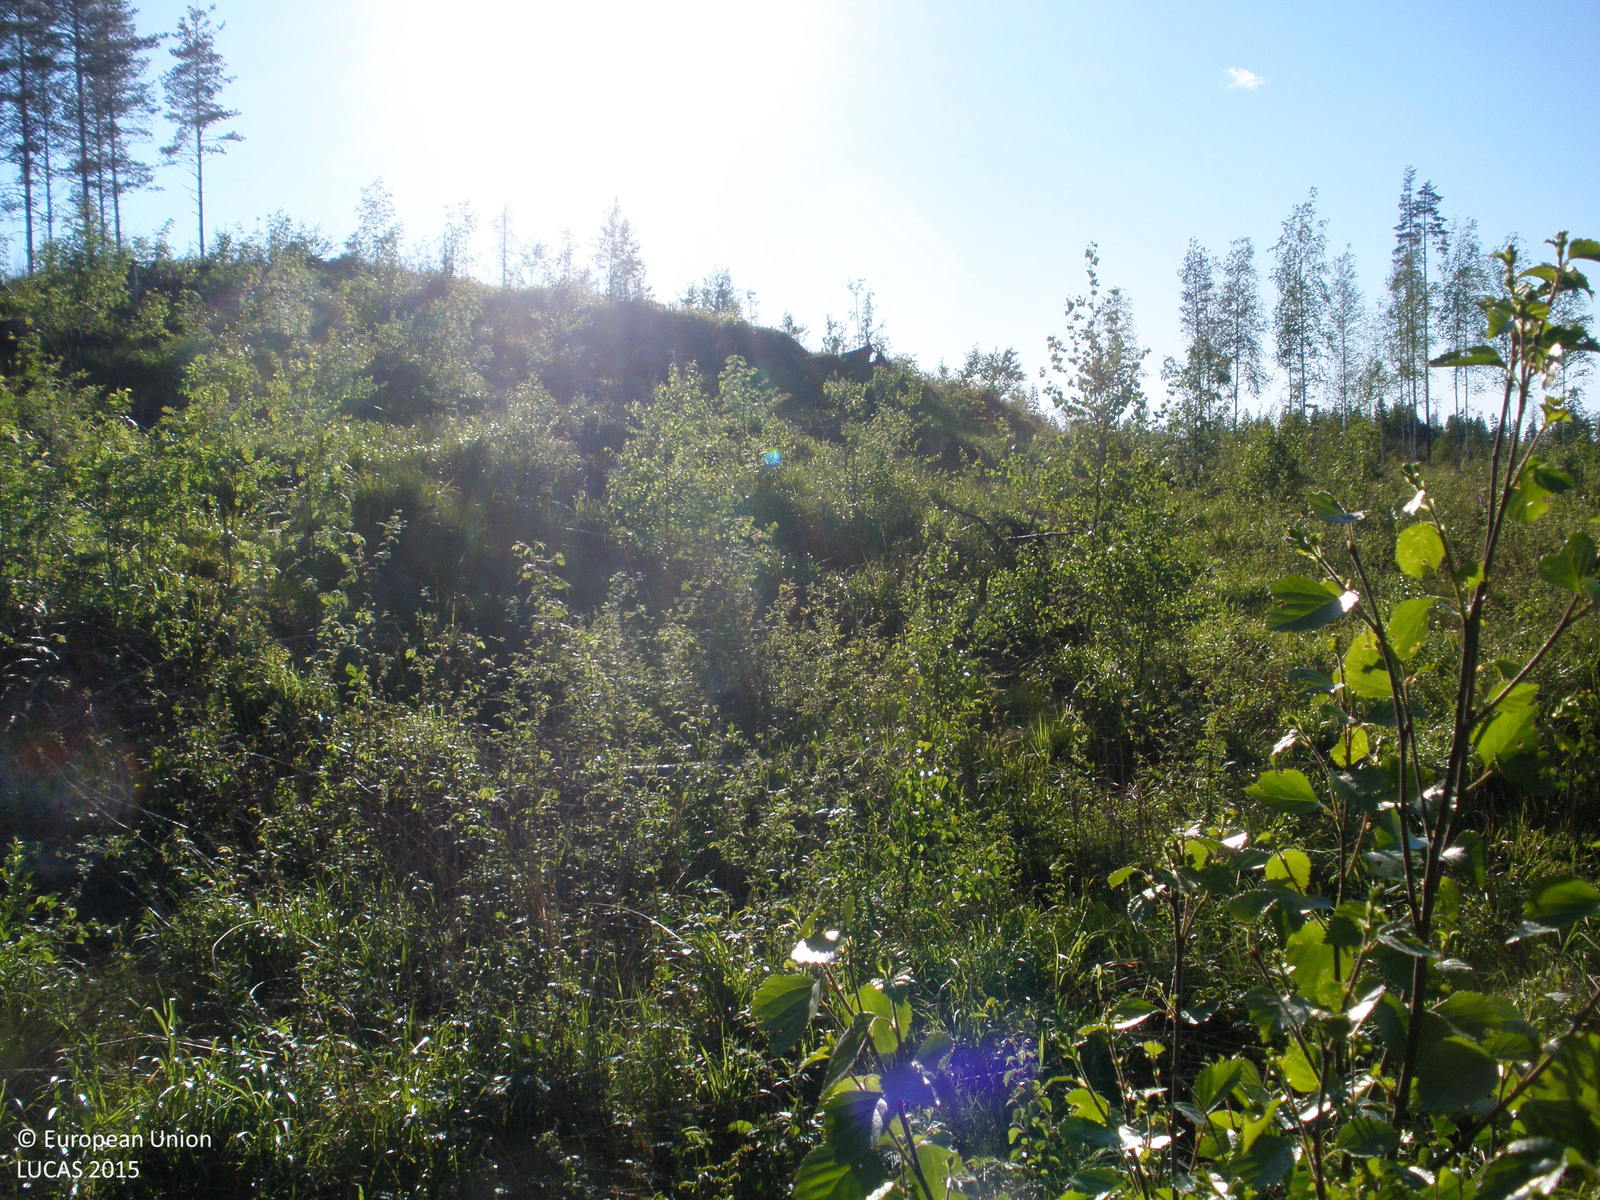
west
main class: Woodland
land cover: Broadleaved woodland
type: boreal forest
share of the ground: 25 - 50 %
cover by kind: broadleaved forest trees 45 %, herbaceous plants 30 %, shrubs 20 %, lichens and mosses 5 %
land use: Forestry
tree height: > 5 m
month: June
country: FI
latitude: 60.8816
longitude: 23.7018
